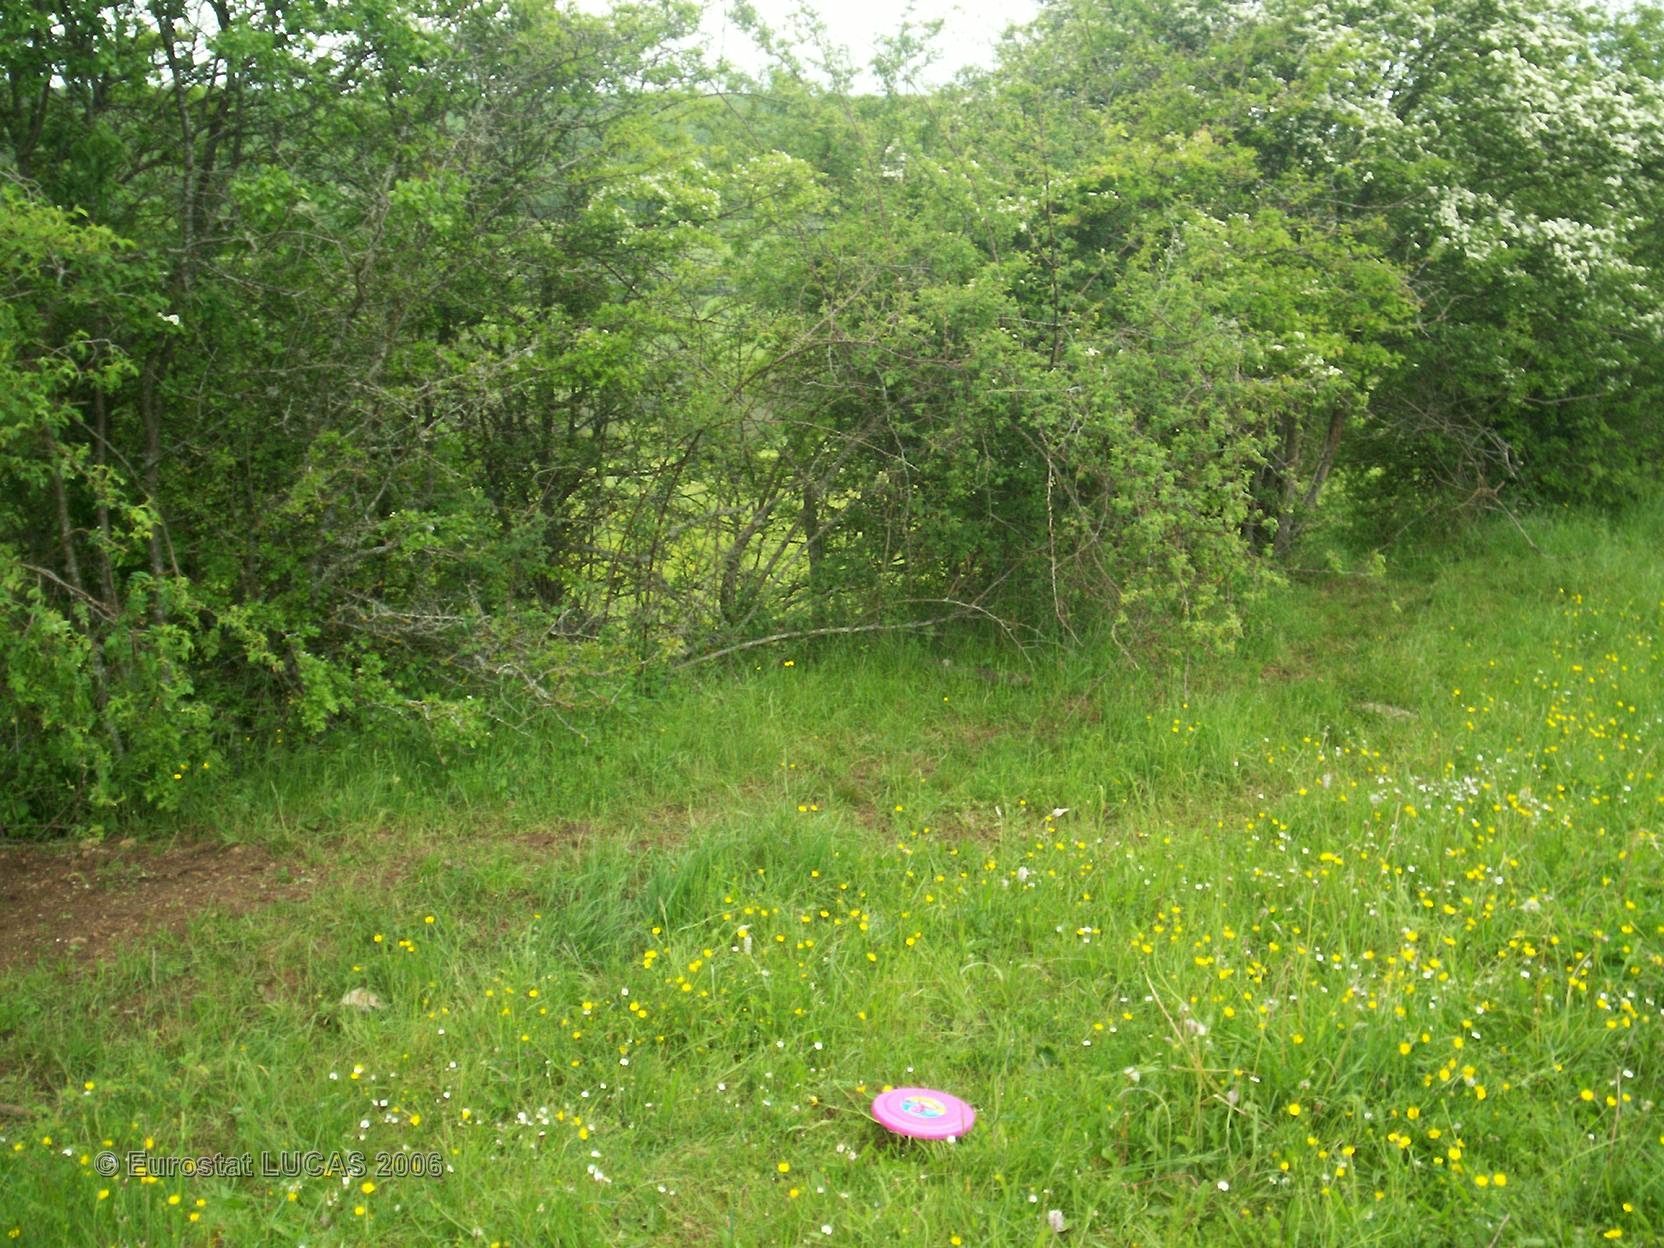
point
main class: Grassland
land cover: Grassland without tree/shrub cover
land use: Agriculture (excluding fallow land and kitchen gardens)
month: May
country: FR
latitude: 47.1741
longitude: 4.6565
